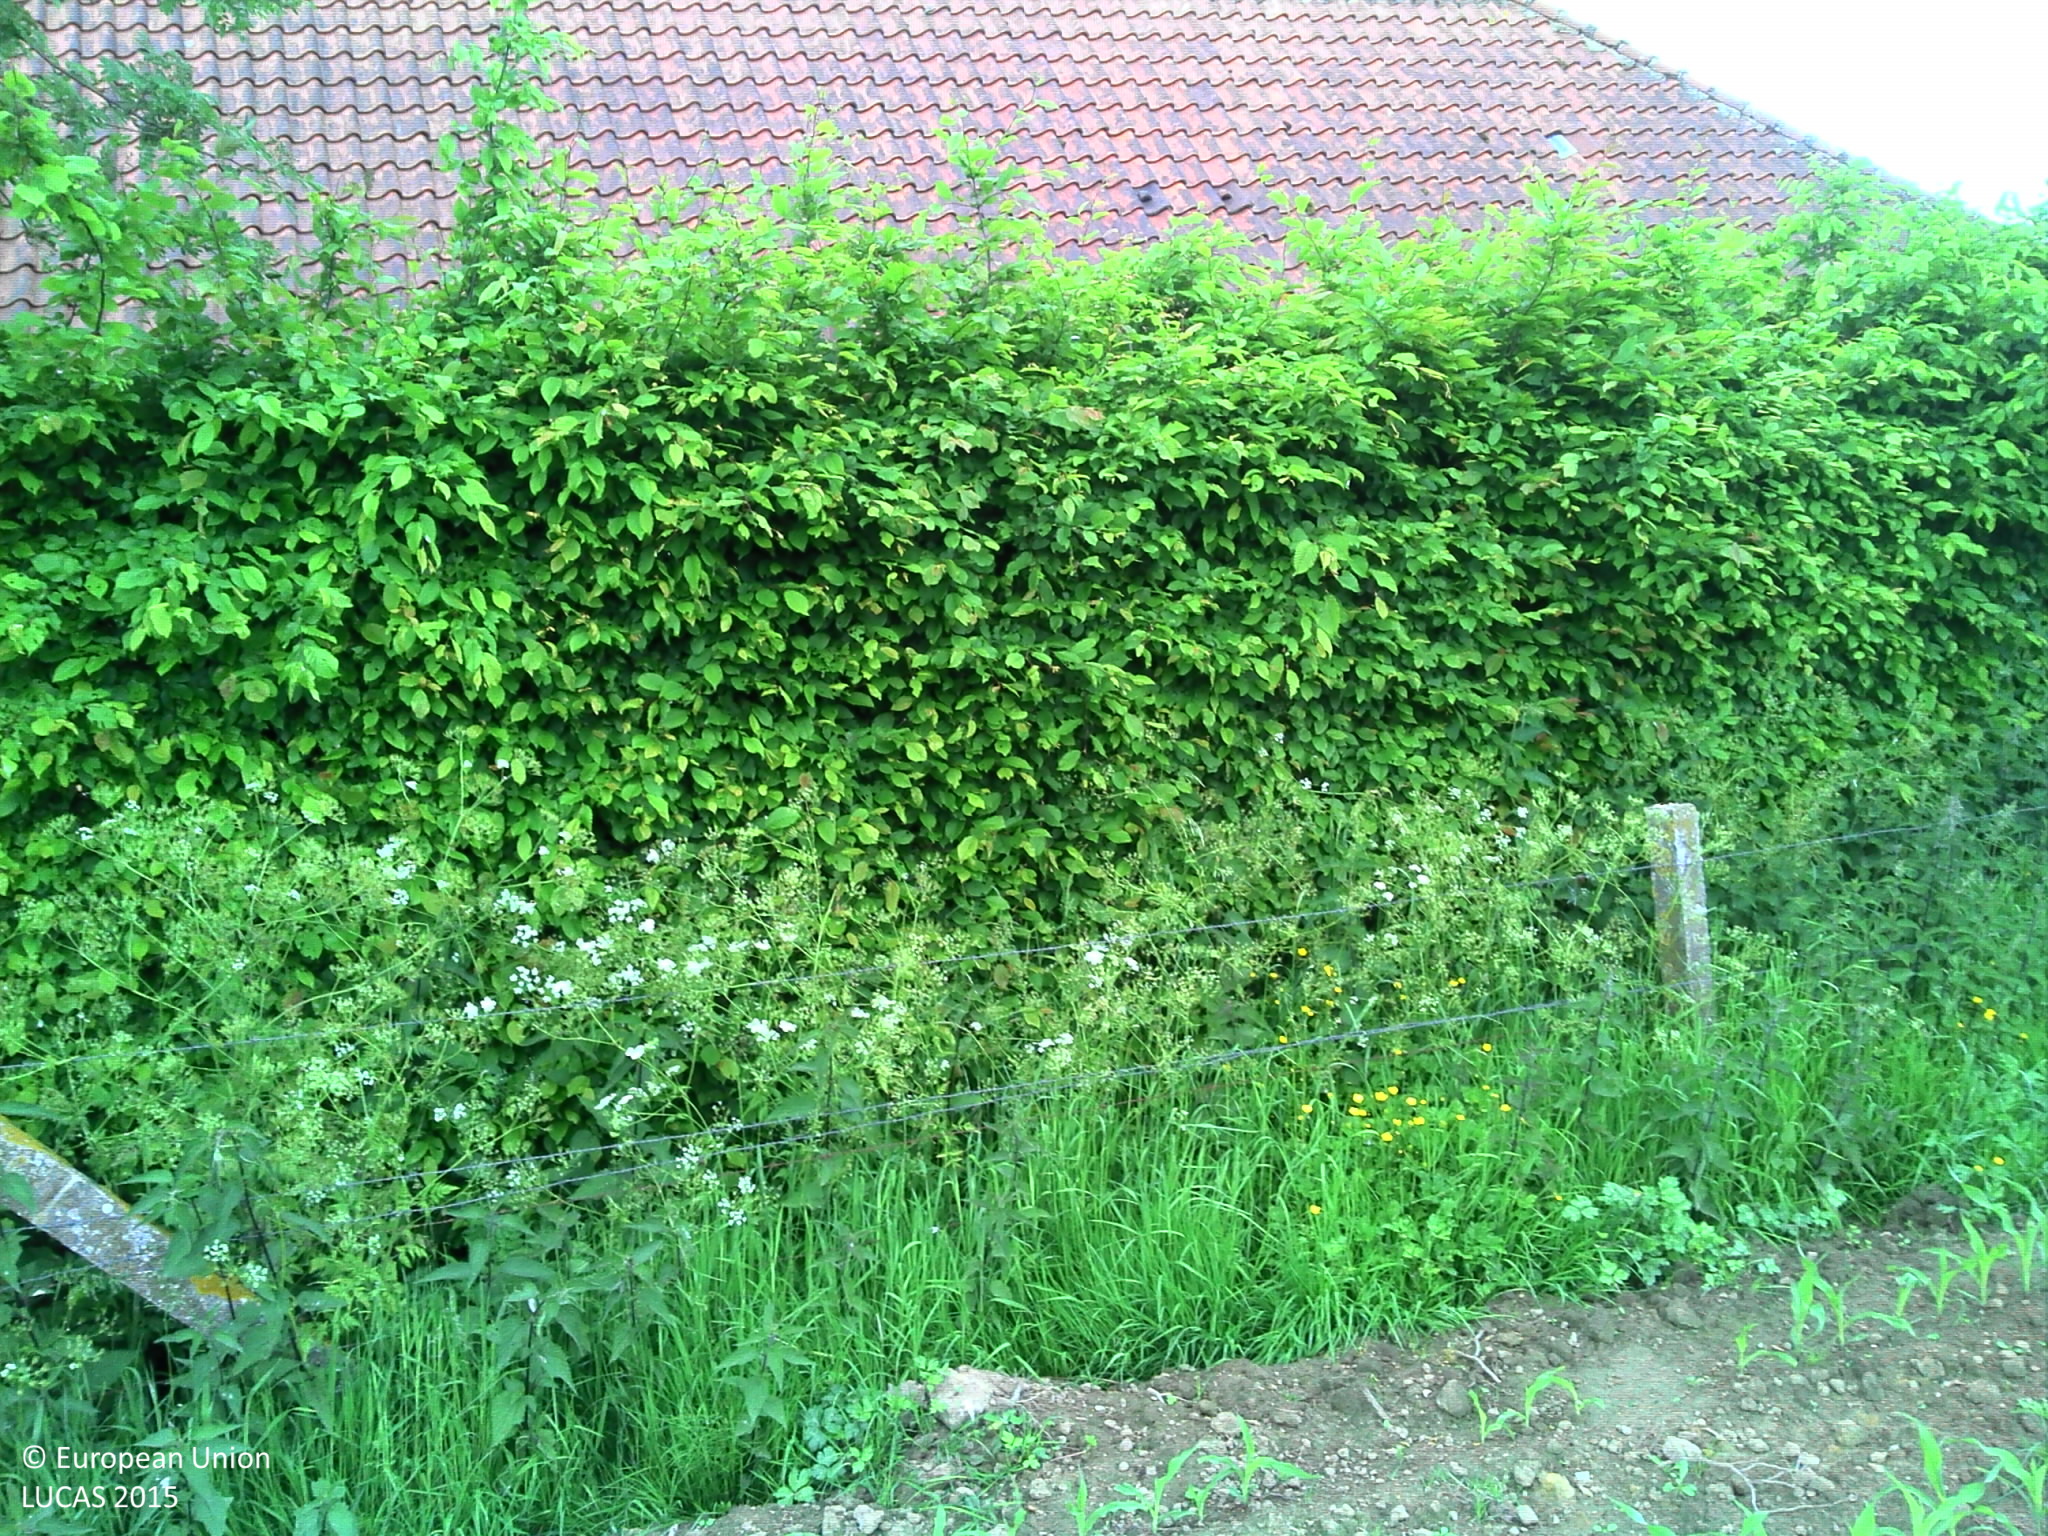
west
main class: Cropland
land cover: Maize
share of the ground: < 10 %
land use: Agriculture (excluding fallow land and kitchen gardens)
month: June
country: BE
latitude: 50.8256
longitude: 3.4474
